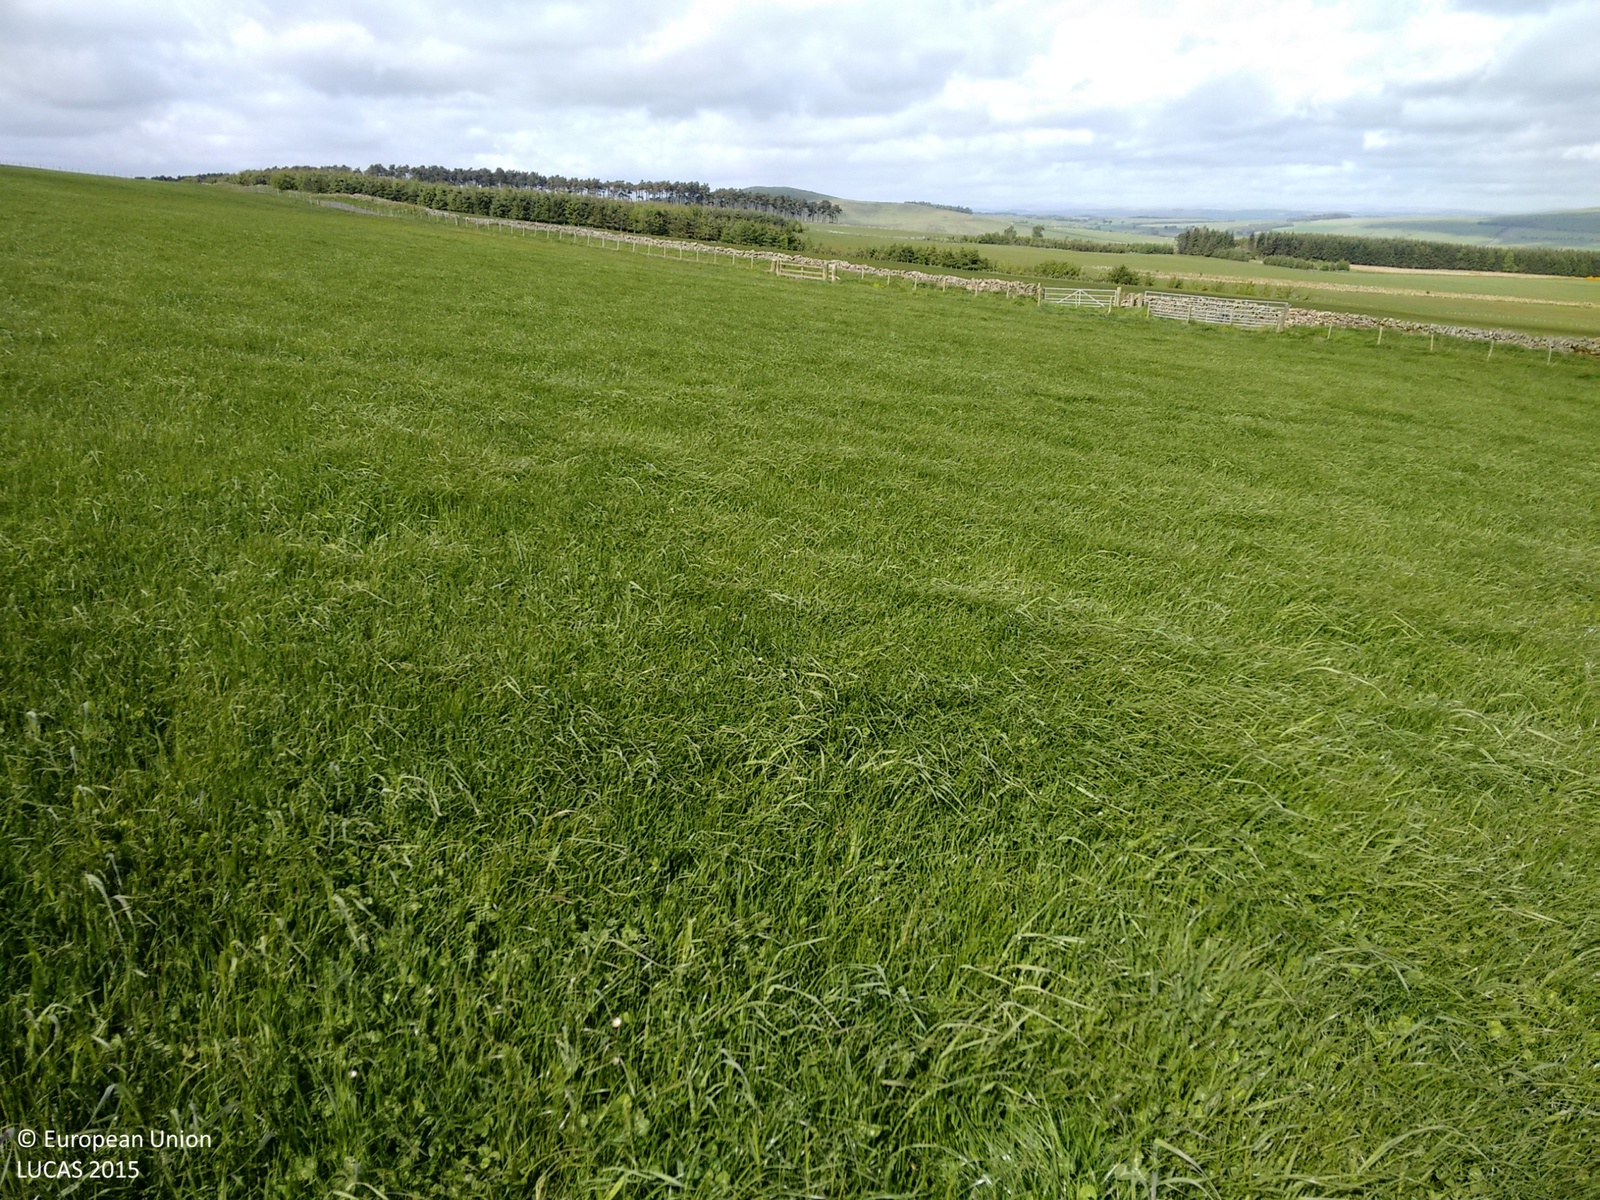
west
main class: Grassland
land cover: Grassland without tree/shrub cover
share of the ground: > 75 %
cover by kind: herbaceous plants 100 %
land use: Agriculture (excluding fallow land and kitchen gardens)
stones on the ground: < 10 %
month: June
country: GB
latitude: 55.4010
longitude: -2.5851
